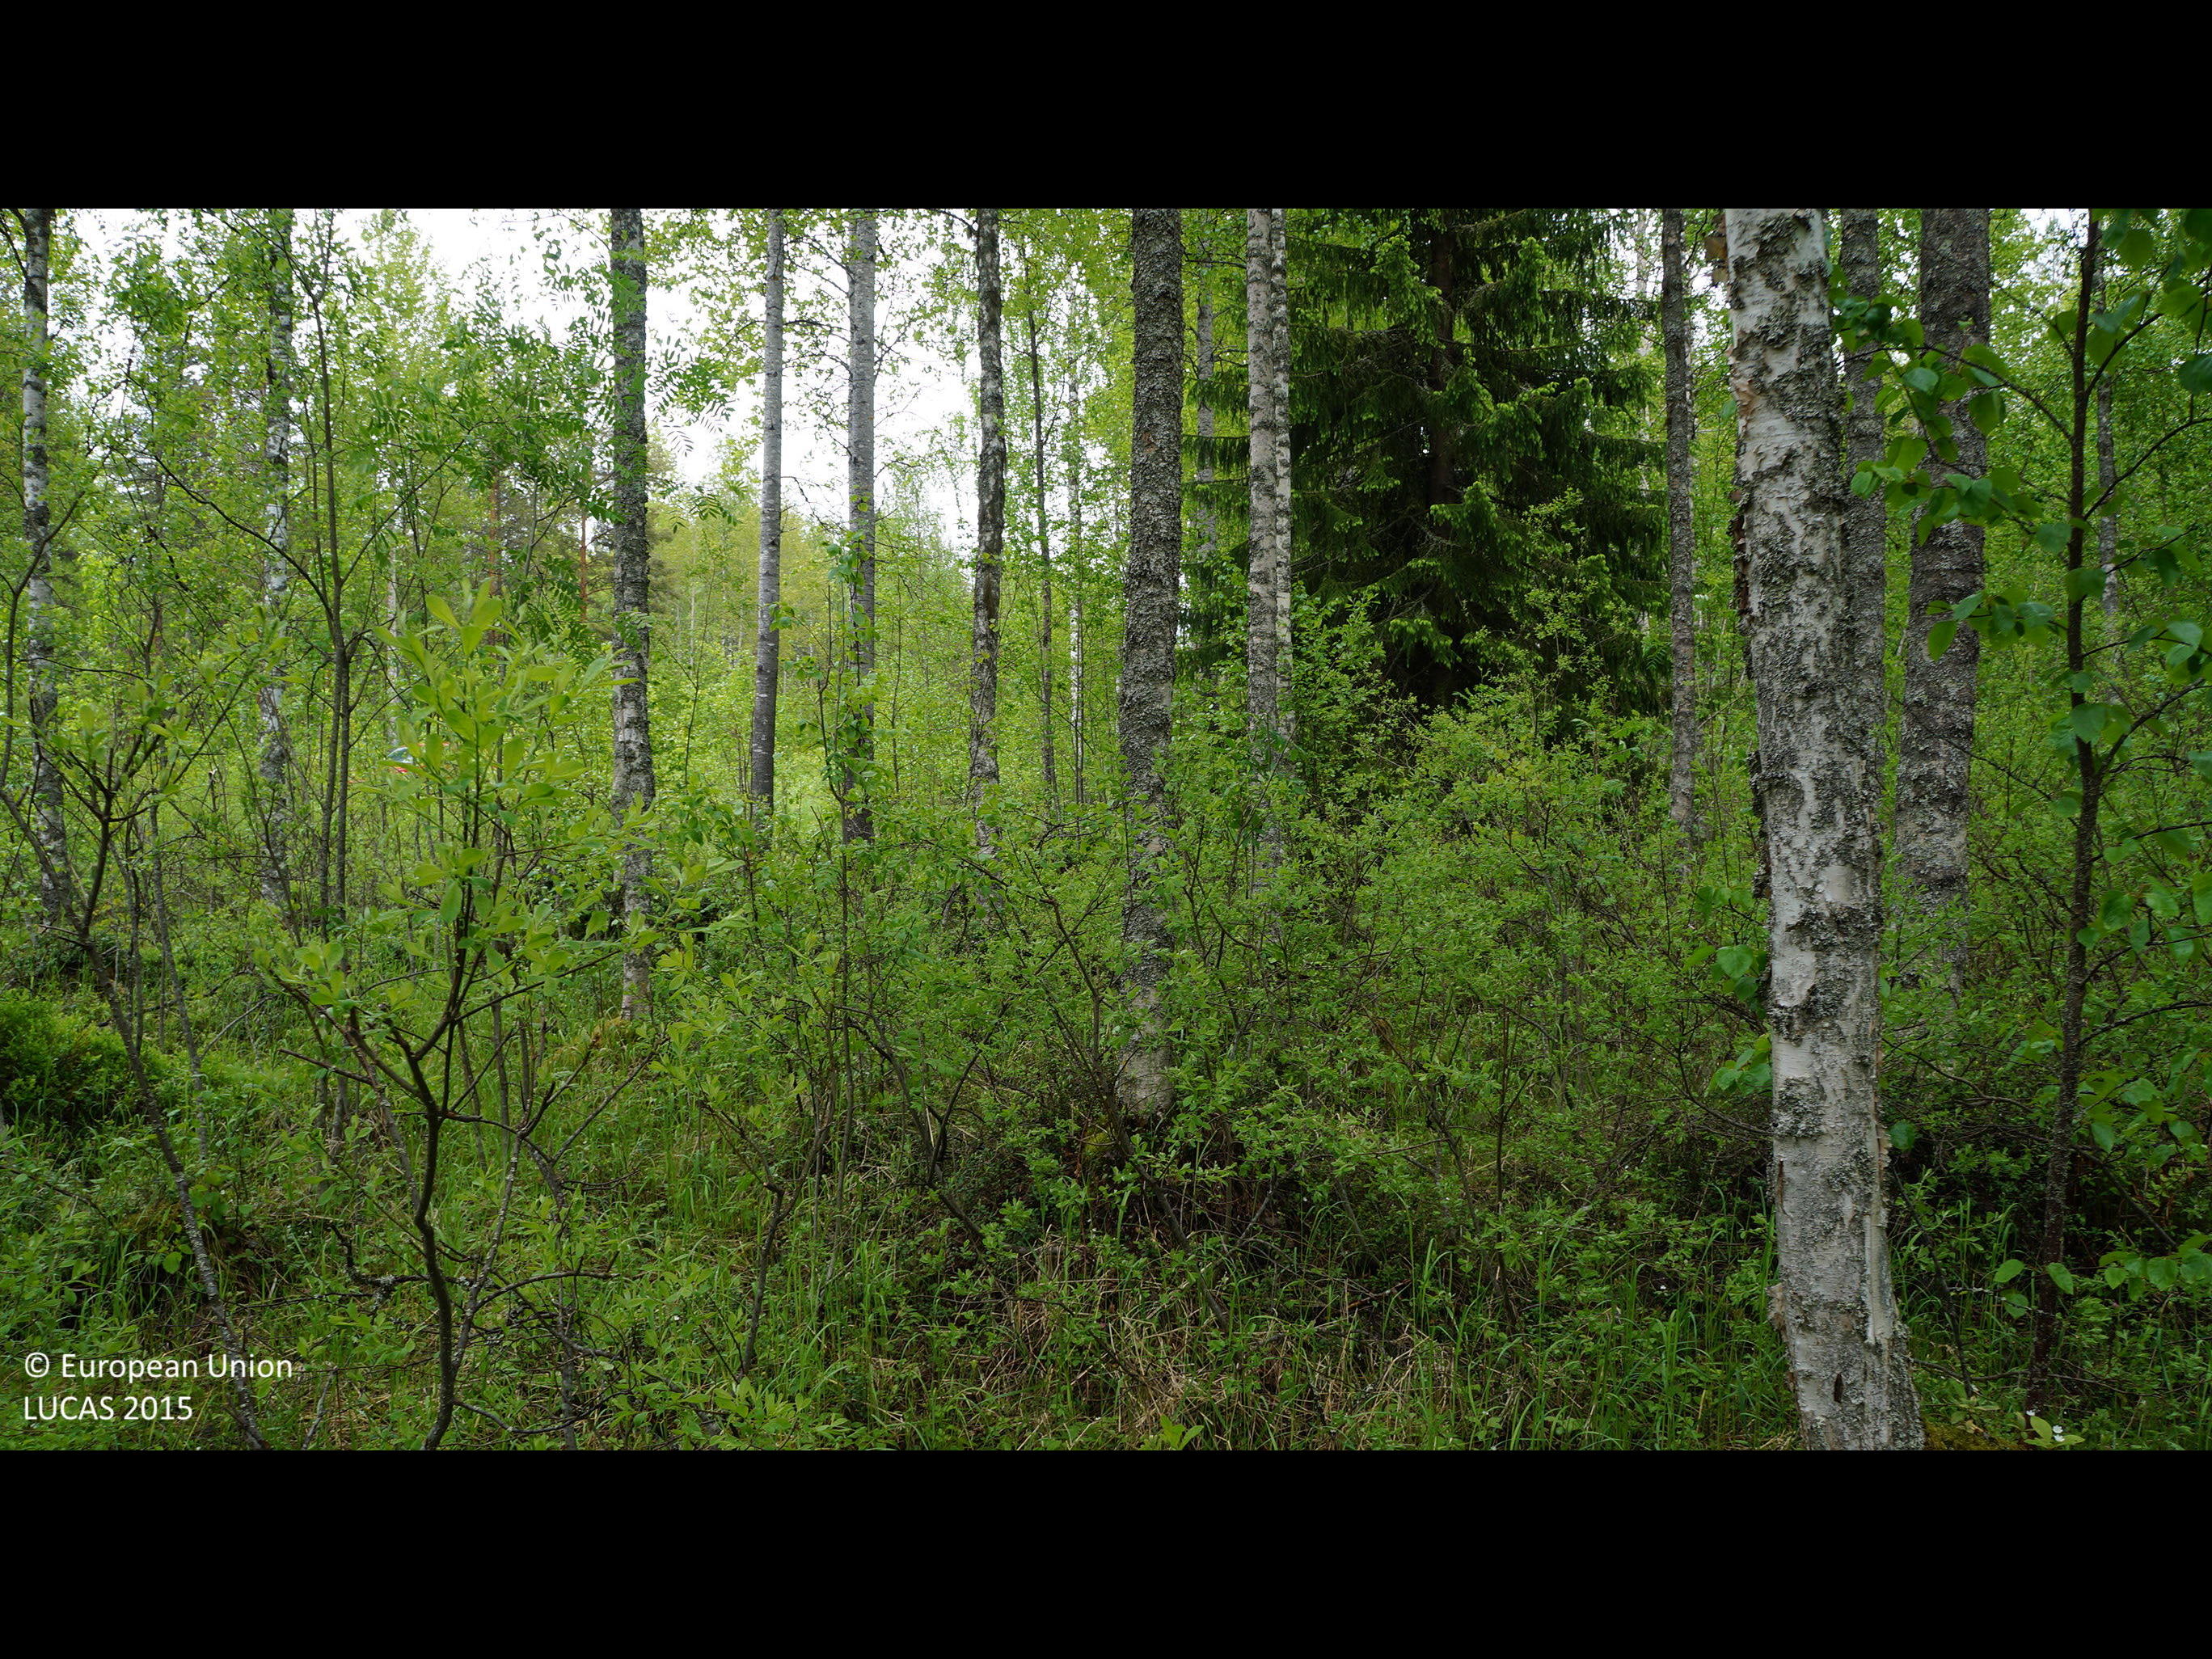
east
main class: Woodland
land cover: Broadleaved woodland
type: boreal forest
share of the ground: 50 - 75 %
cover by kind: broadleaved forest trees 65 %, shrubs 25 %, coniferous forest trees 5 %, herbaceous plants 5 %
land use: Forestry
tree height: > 5 m
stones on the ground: < 10 %
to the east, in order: Broadleaved woodland; Ditches and canals; Broadleaved woodland; Ditches and canals; Shruby margins; Paved roads, cycling and walking lanes; Shruby margins; Abandoned hedges; Ditches and canals; Broadleaved woodland; Pine dominated mixed woodland; Pine dominated coniferous woodland; Pine dominated mixed woodland; Ditches and canals; Pine dominated mixed woodland
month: June
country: FI
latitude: 64.2772
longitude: 25.3077
